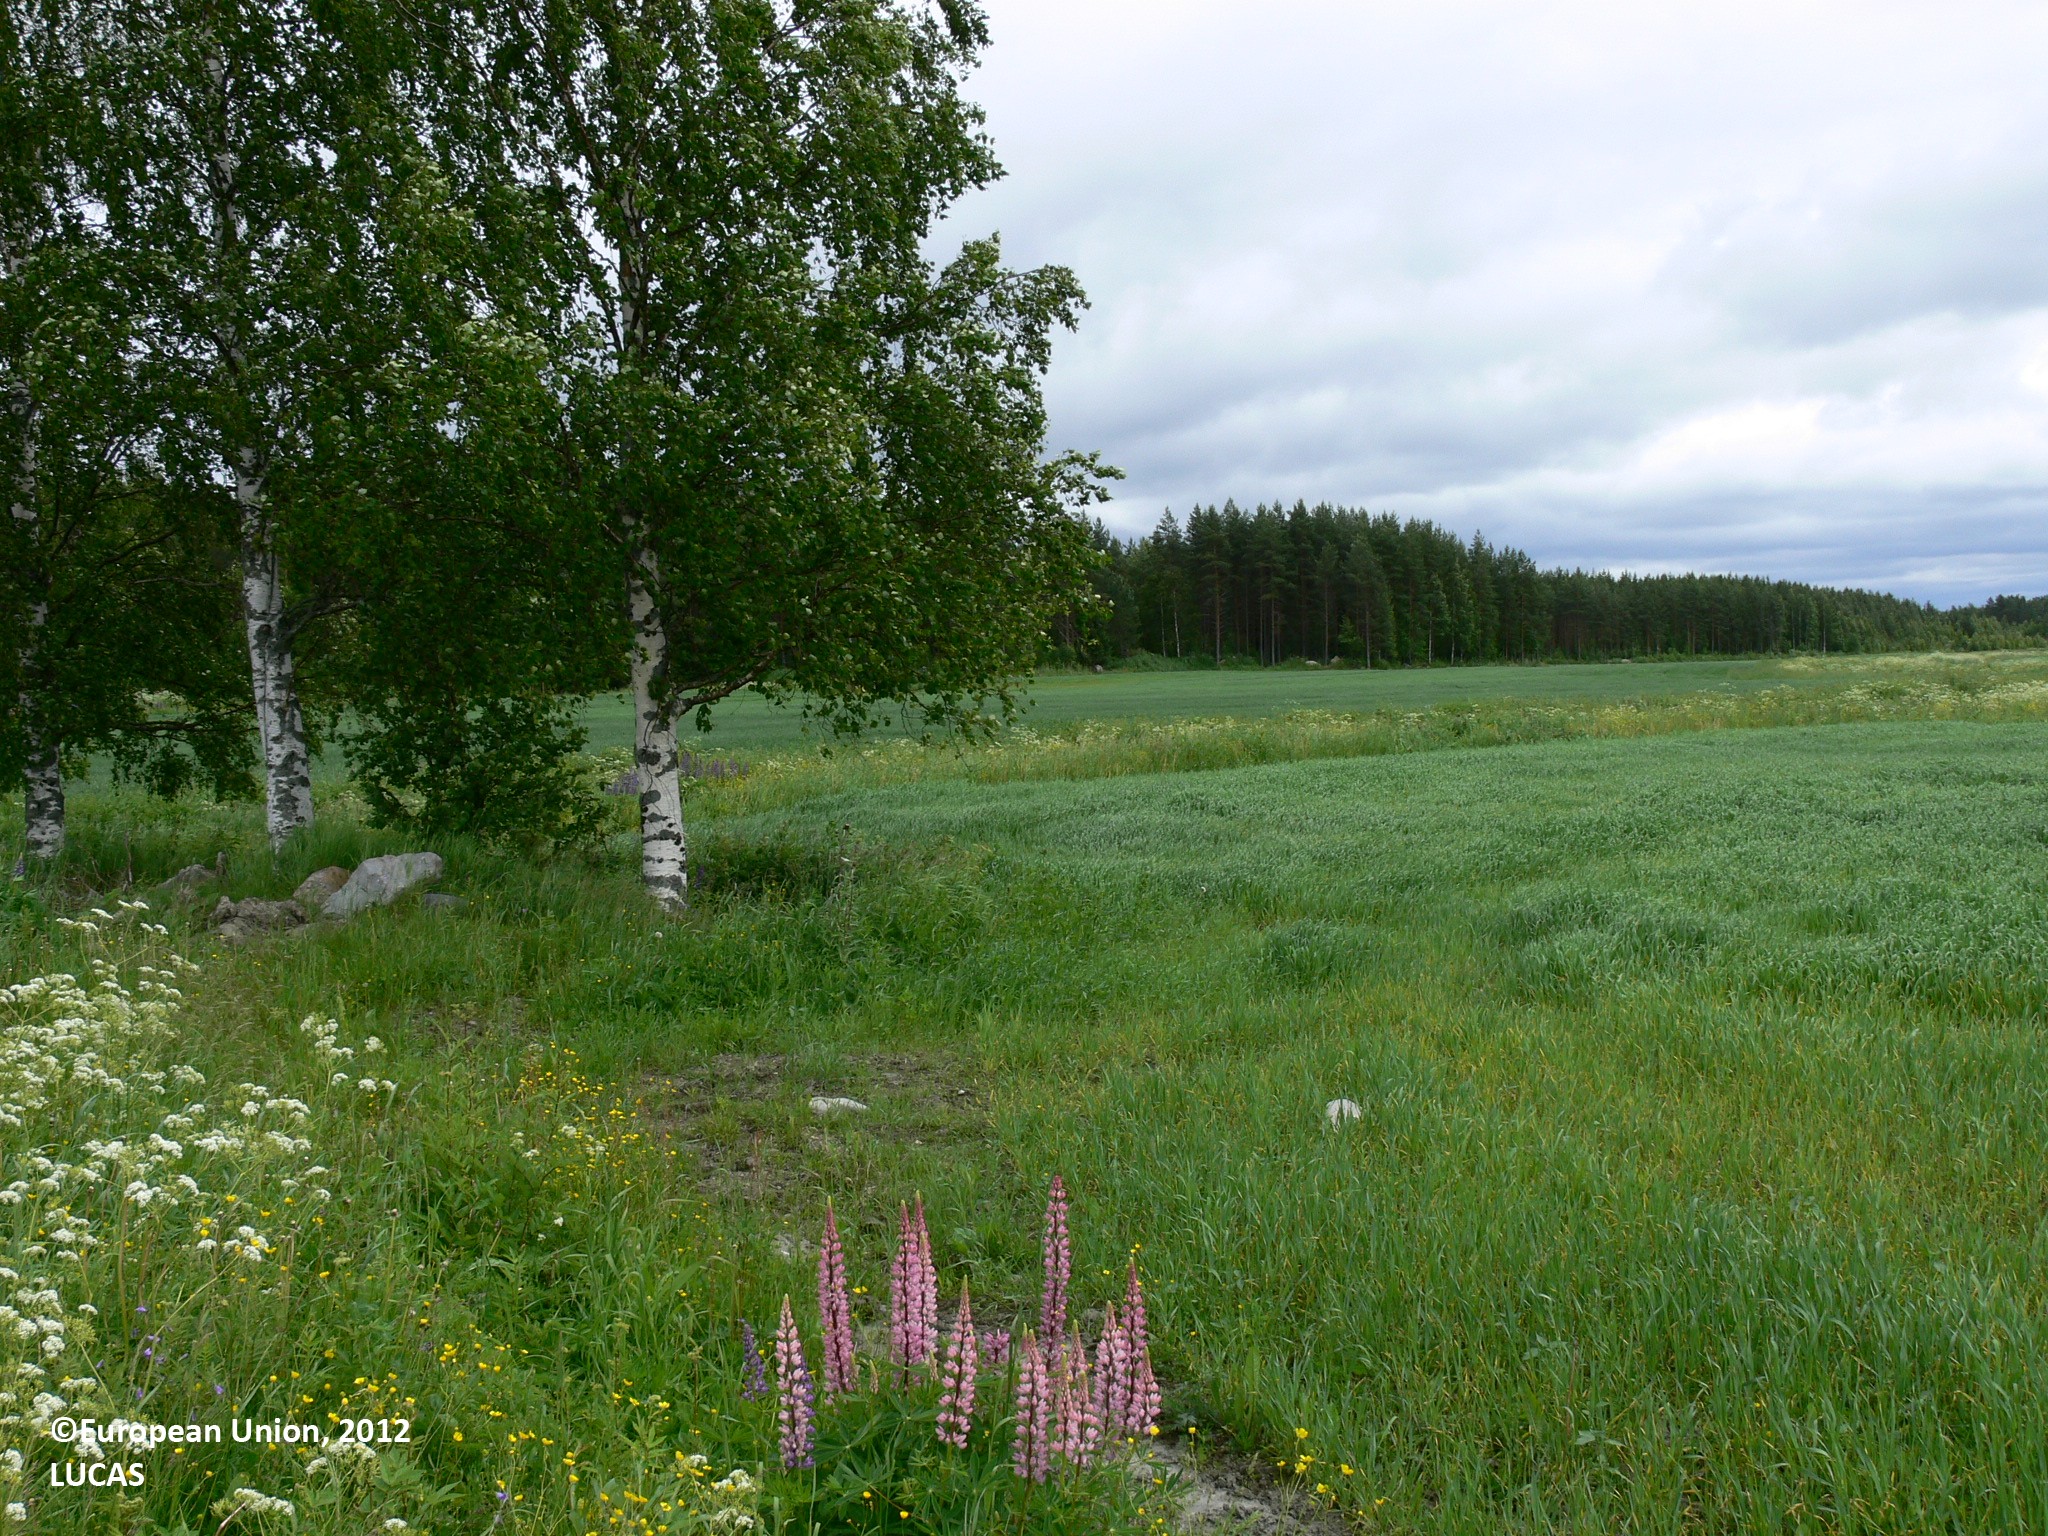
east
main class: Cropland
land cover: Barley
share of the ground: > 75 %
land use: Agriculture (excluding fallow land and kitchen gardens)
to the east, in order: Barley; Ditches and canals; Barley; Ditches and canals; Barley; Ditches and canals; Barley; Ditches and canals; Other mixed woodland
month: June
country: FI
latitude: 62.8216
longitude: 29.2819
